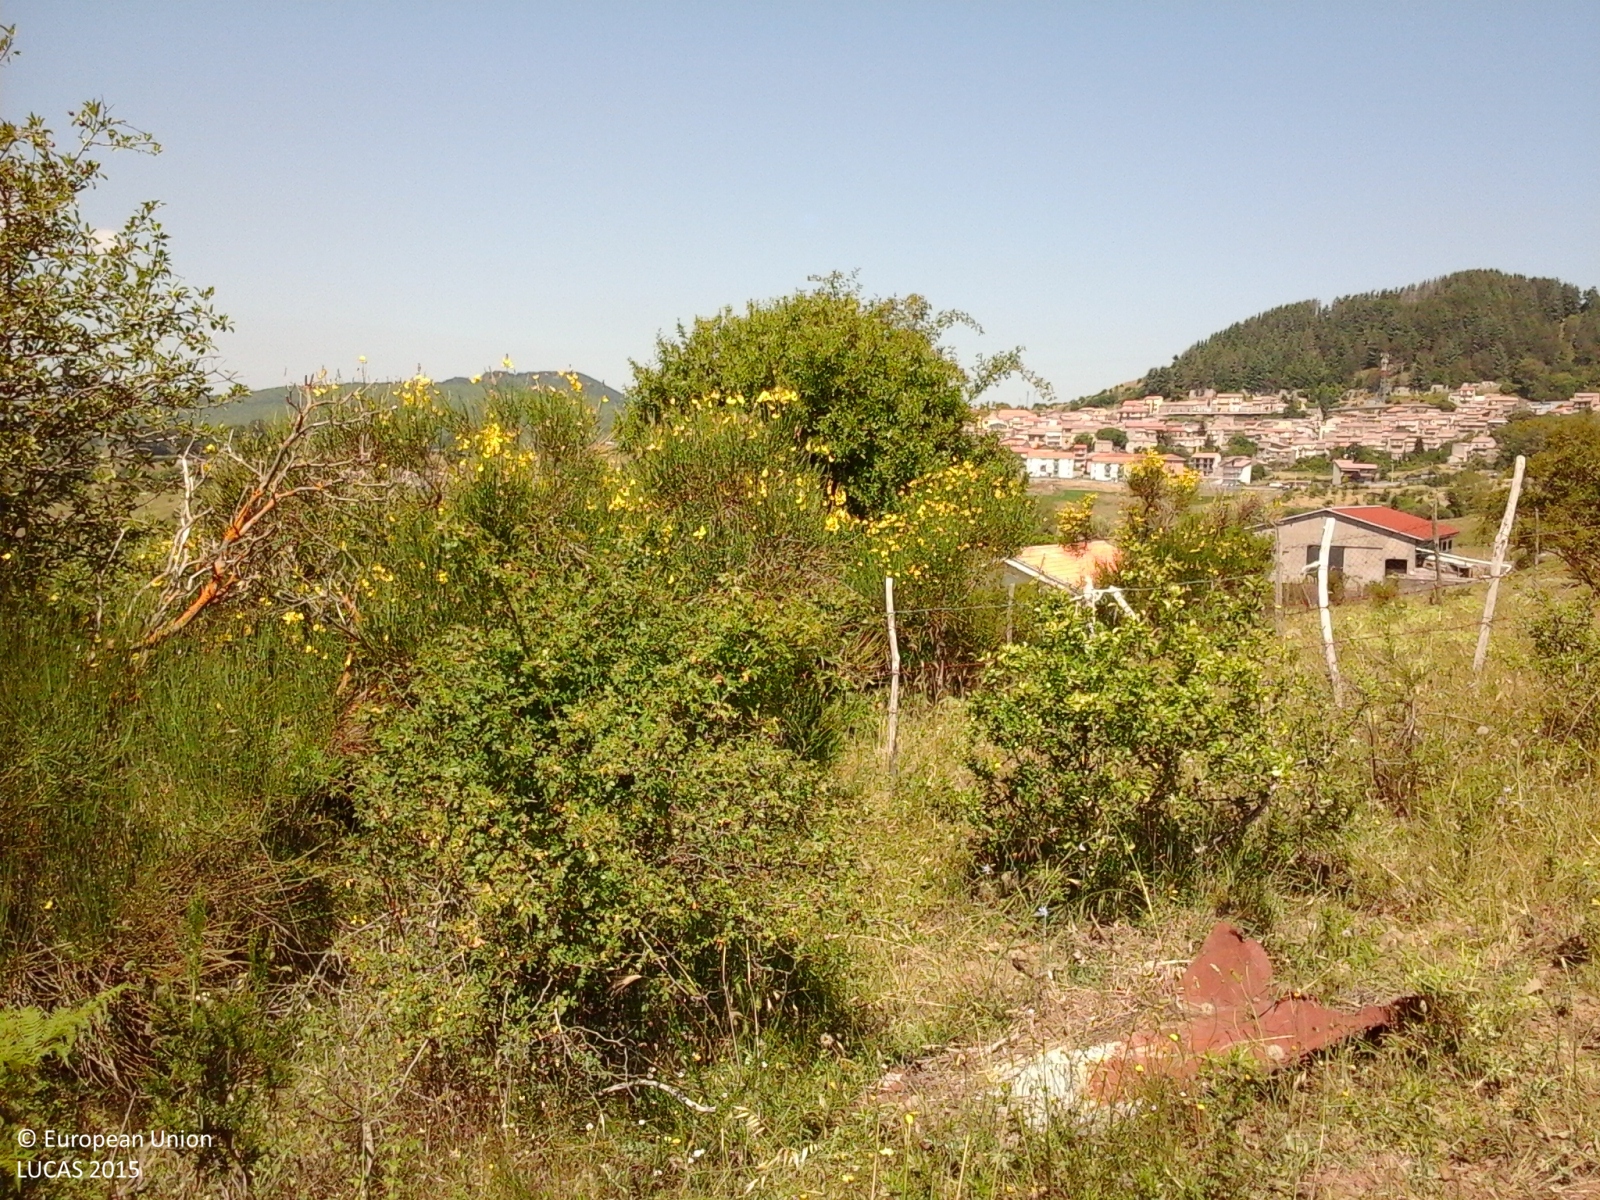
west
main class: Shrubland
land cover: Shrubland with sparse tree cover
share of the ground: > 75 %
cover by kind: shrubs 95 %, broadleaved forest trees 5 %
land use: Agriculture (excluding fallow land and kitchen gardens)
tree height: < 5 m
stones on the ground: 25 - 50 %
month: July
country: IT
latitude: 37.9837
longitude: 14.9197
